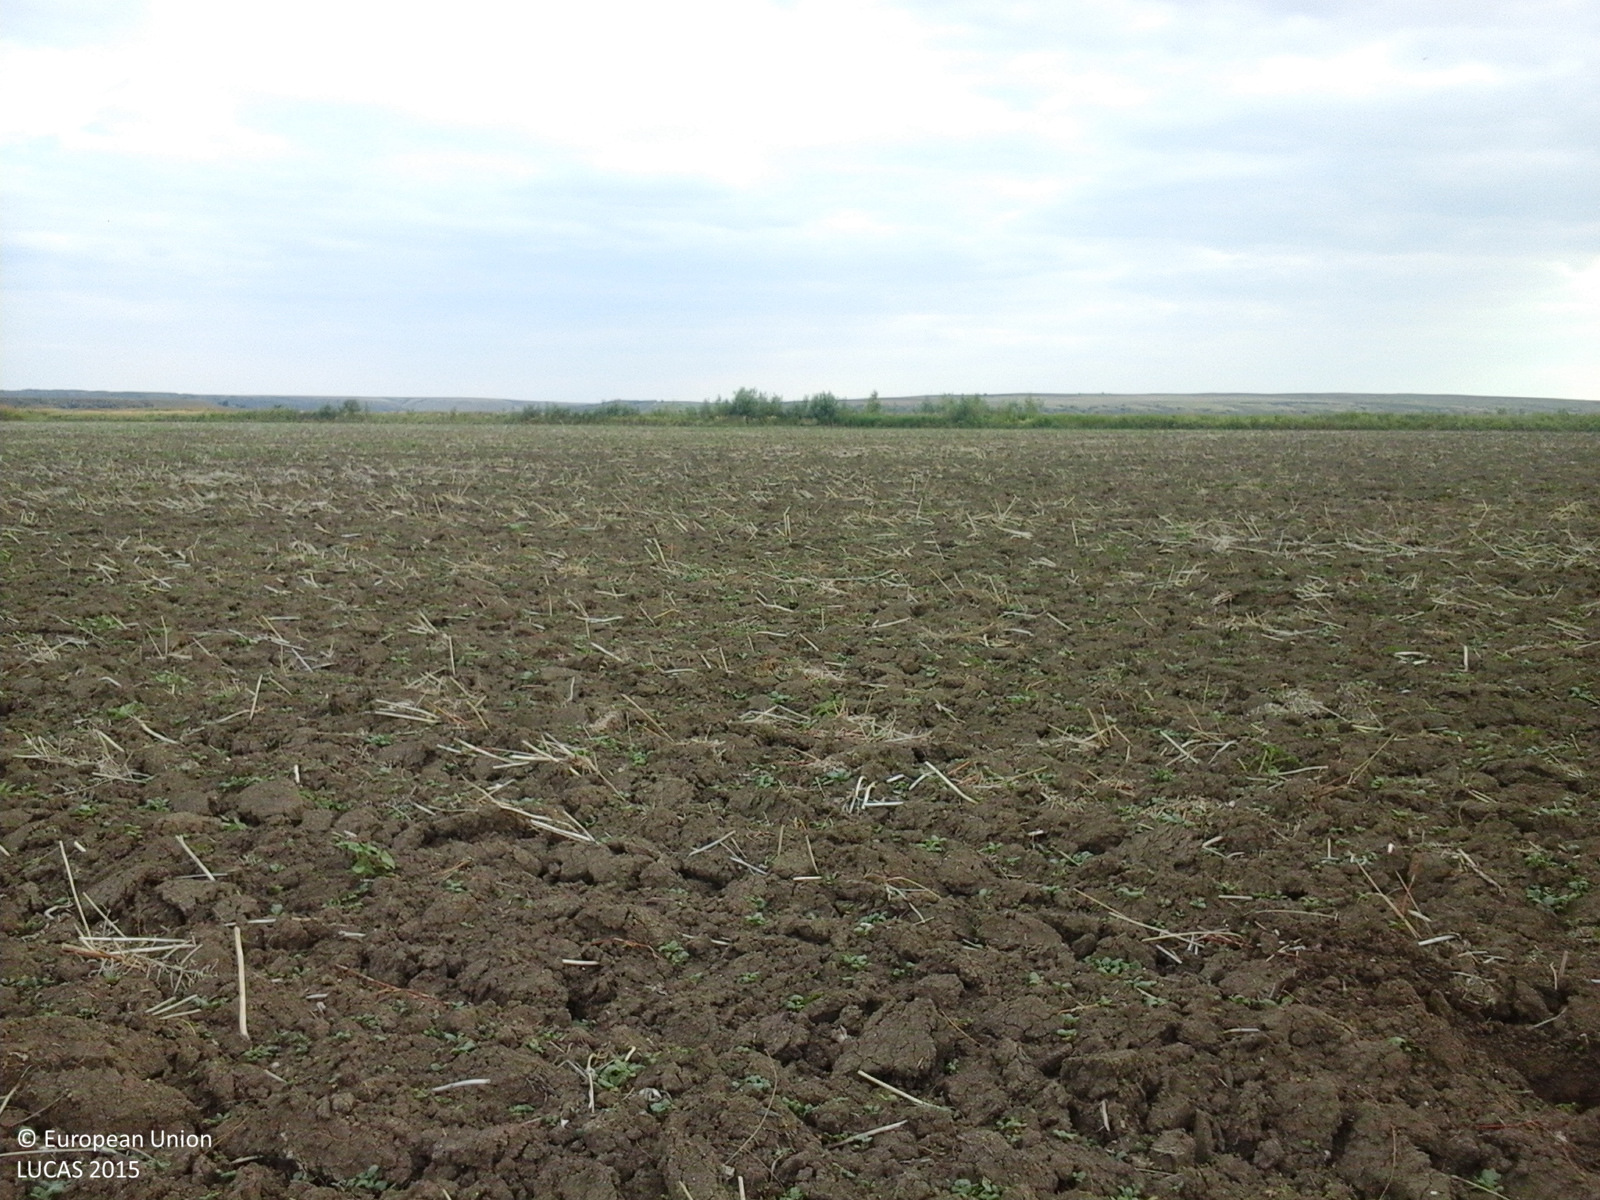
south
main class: Cropland
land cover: Rape and turnip rape
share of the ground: < 10 %
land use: Agriculture (excluding fallow land and kitchen gardens)
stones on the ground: < 10 %
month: August
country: RO
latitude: 44.7422
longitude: 28.0583
